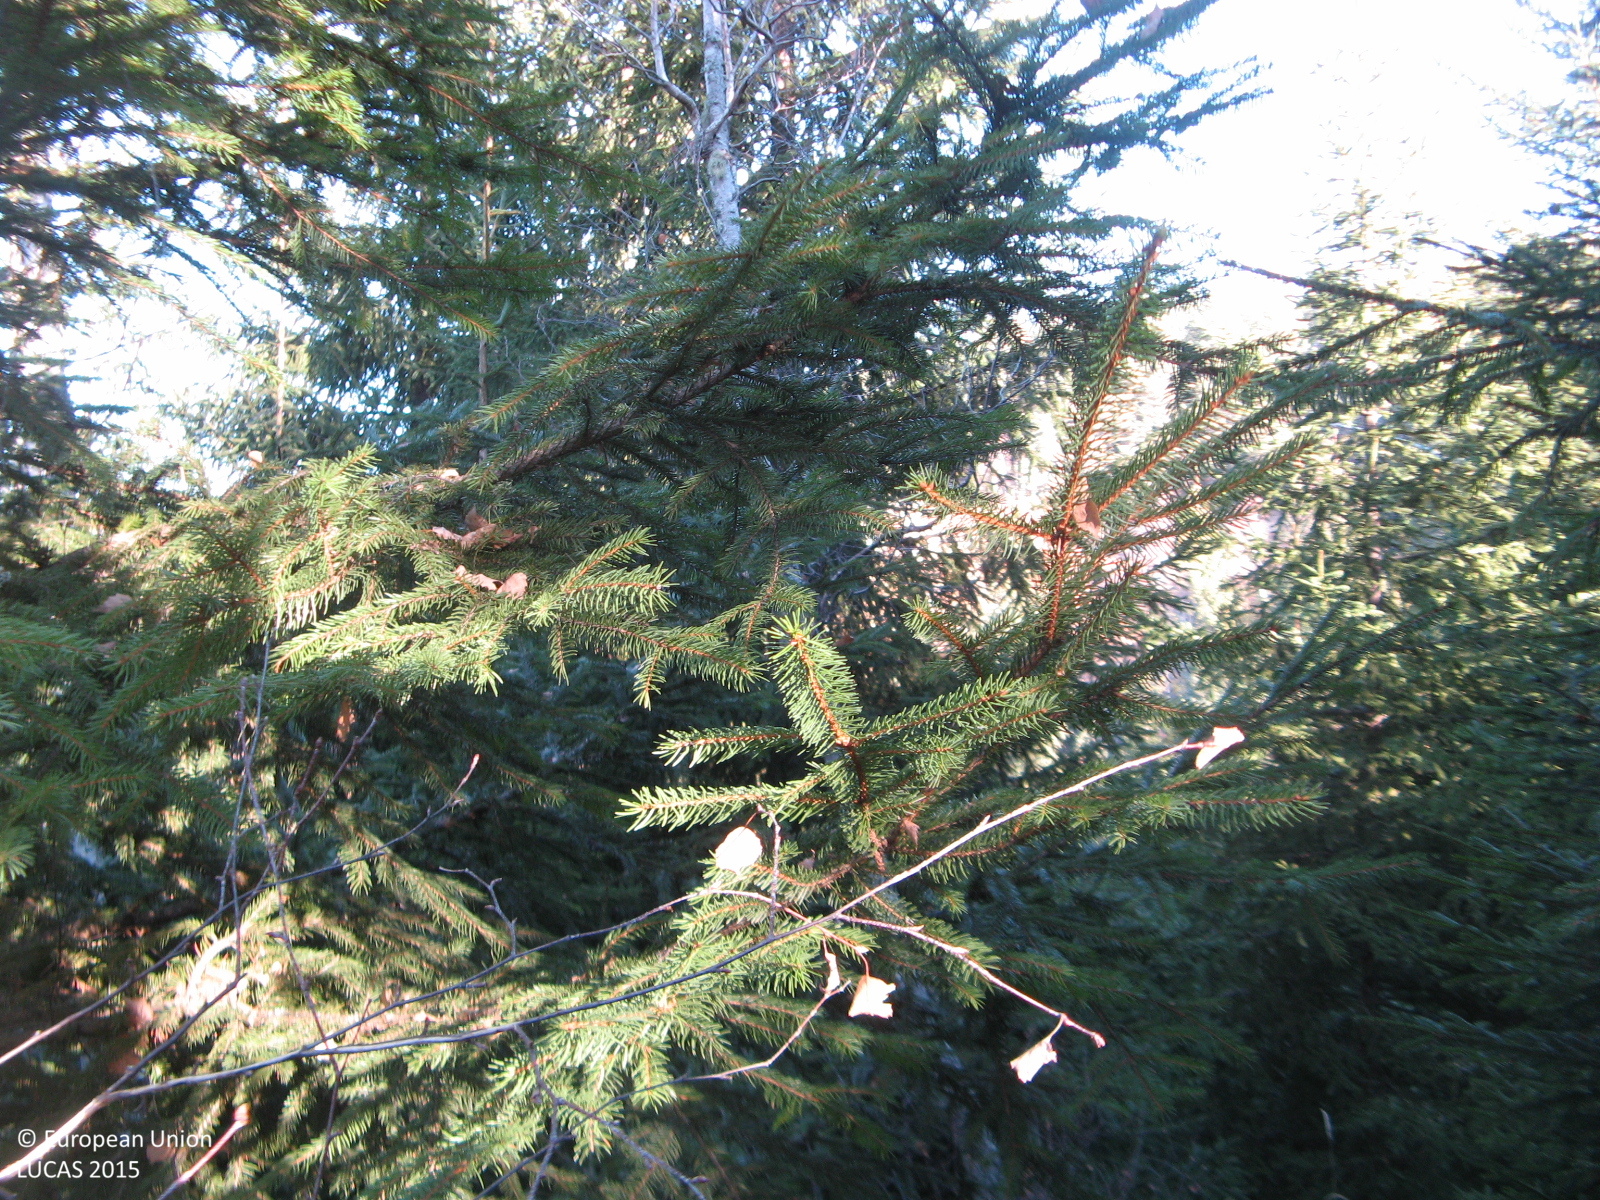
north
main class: Woodland
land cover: Other mixed woodland
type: hemiboreal forest and nemoral coniferous forest and mixed broadleaved-coniferous forest
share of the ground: > 75 %
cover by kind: coniferous forest trees 75 %, broadleaved forest trees 25 %
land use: Forestry
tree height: > 5 m
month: December
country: BG
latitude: 41.6336
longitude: 24.0425
